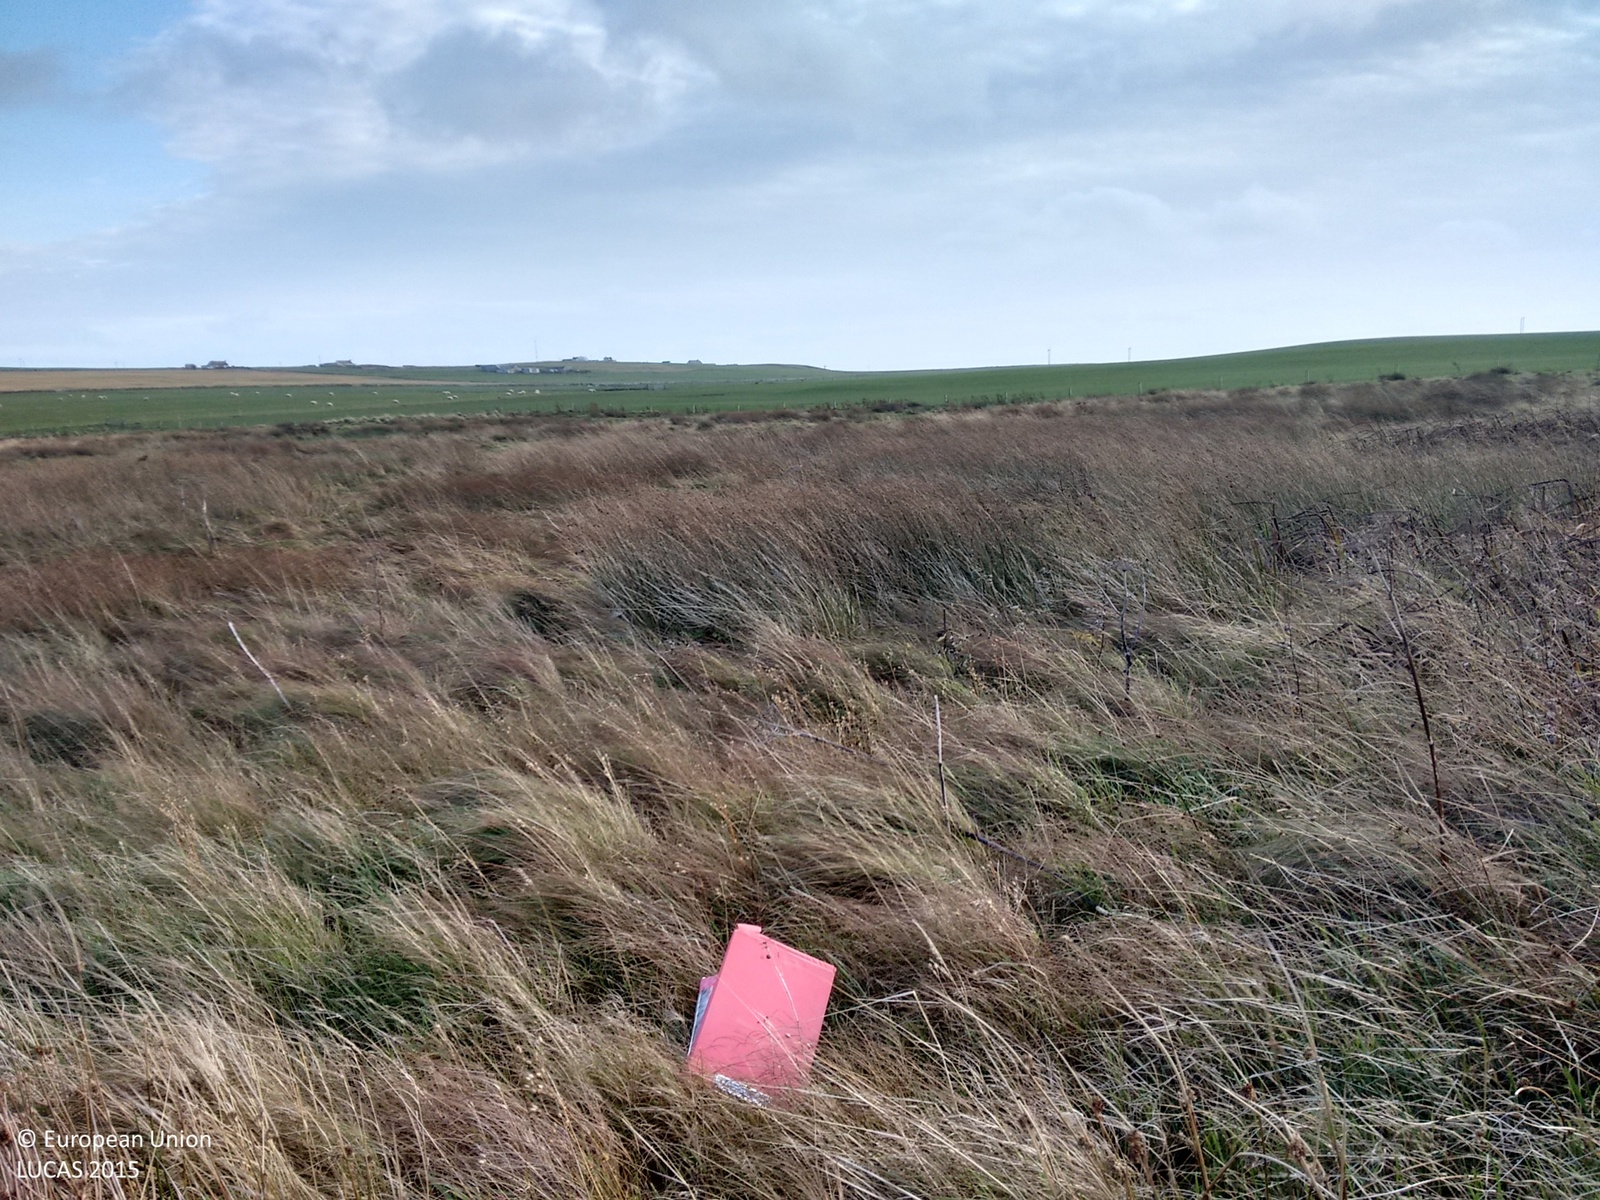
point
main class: Grassland
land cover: Grassland without tree/shrub cover
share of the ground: > 75 %
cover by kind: herbaceous plants 100 %
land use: Agriculture (excluding fallow land and kitchen gardens)
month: November
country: GB
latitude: 58.9381
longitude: -2.7860
